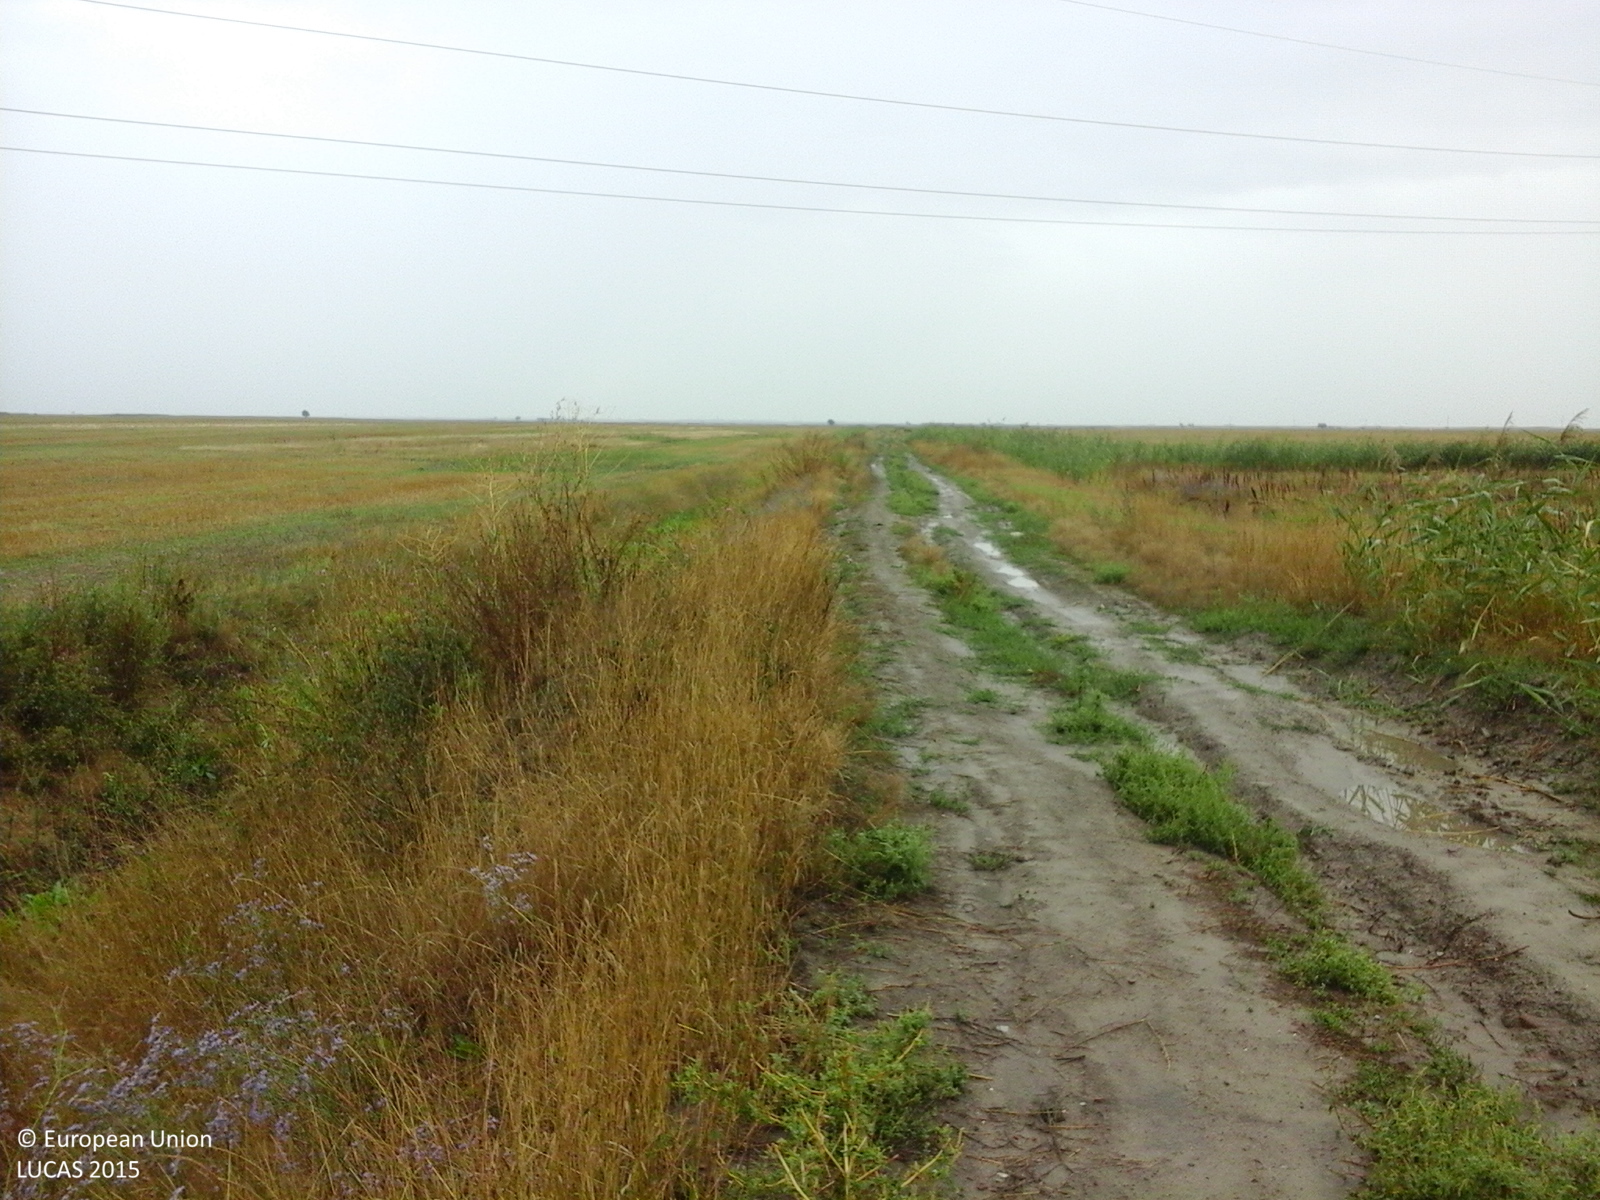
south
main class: Cropland
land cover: Common wheat
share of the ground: < 10 %
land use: Agriculture (excluding fallow land and kitchen gardens)
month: August
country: RO
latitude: 45.6015
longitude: 20.9888
